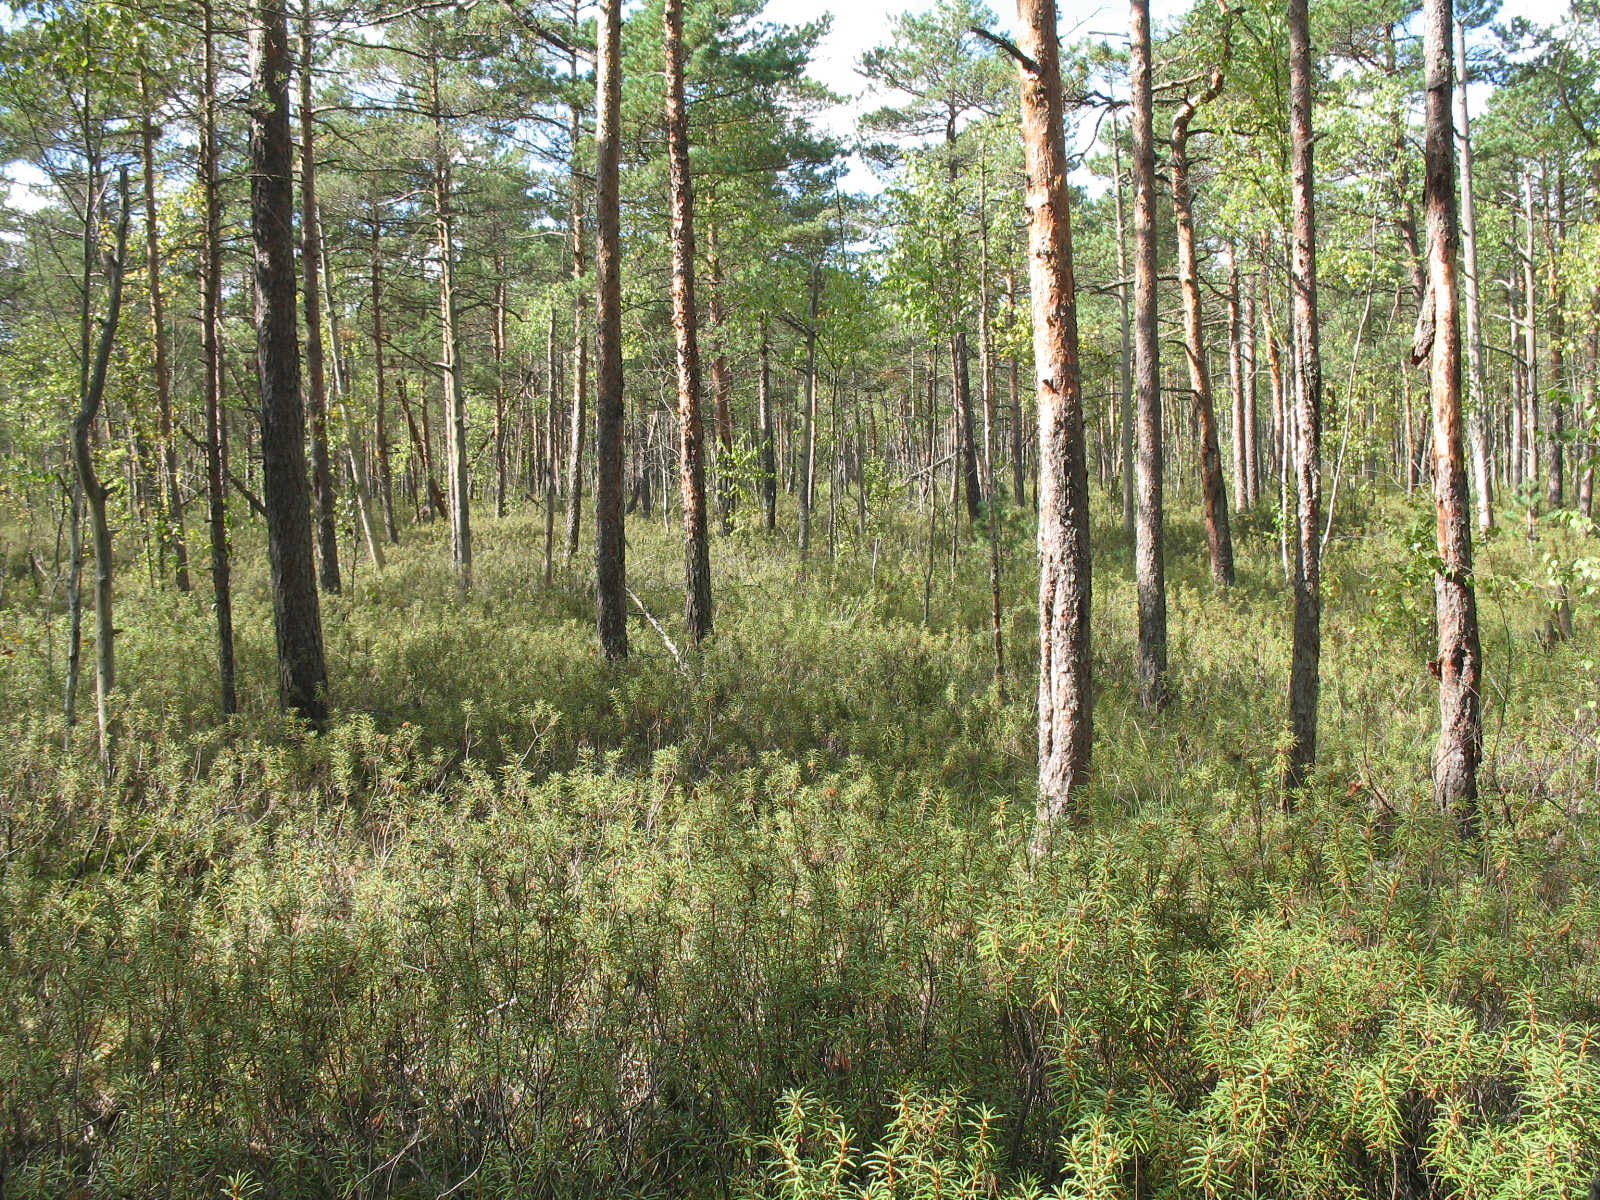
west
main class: Woodland
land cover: Pine dominated coniferous woodland
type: hemiboreal forest and nemoral coniferous forest and mixed broadleaved-coniferous forest
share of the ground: 25 - 50 %
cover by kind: coniferous forest trees 40 %, lichens and mosses 30 %, herbaceous plants 15 %, shrubs 10 %, broadleaved forest trees 5 %
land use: Forestry
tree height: > 5 m
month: September
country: LV
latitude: 56.1631
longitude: 25.4337
